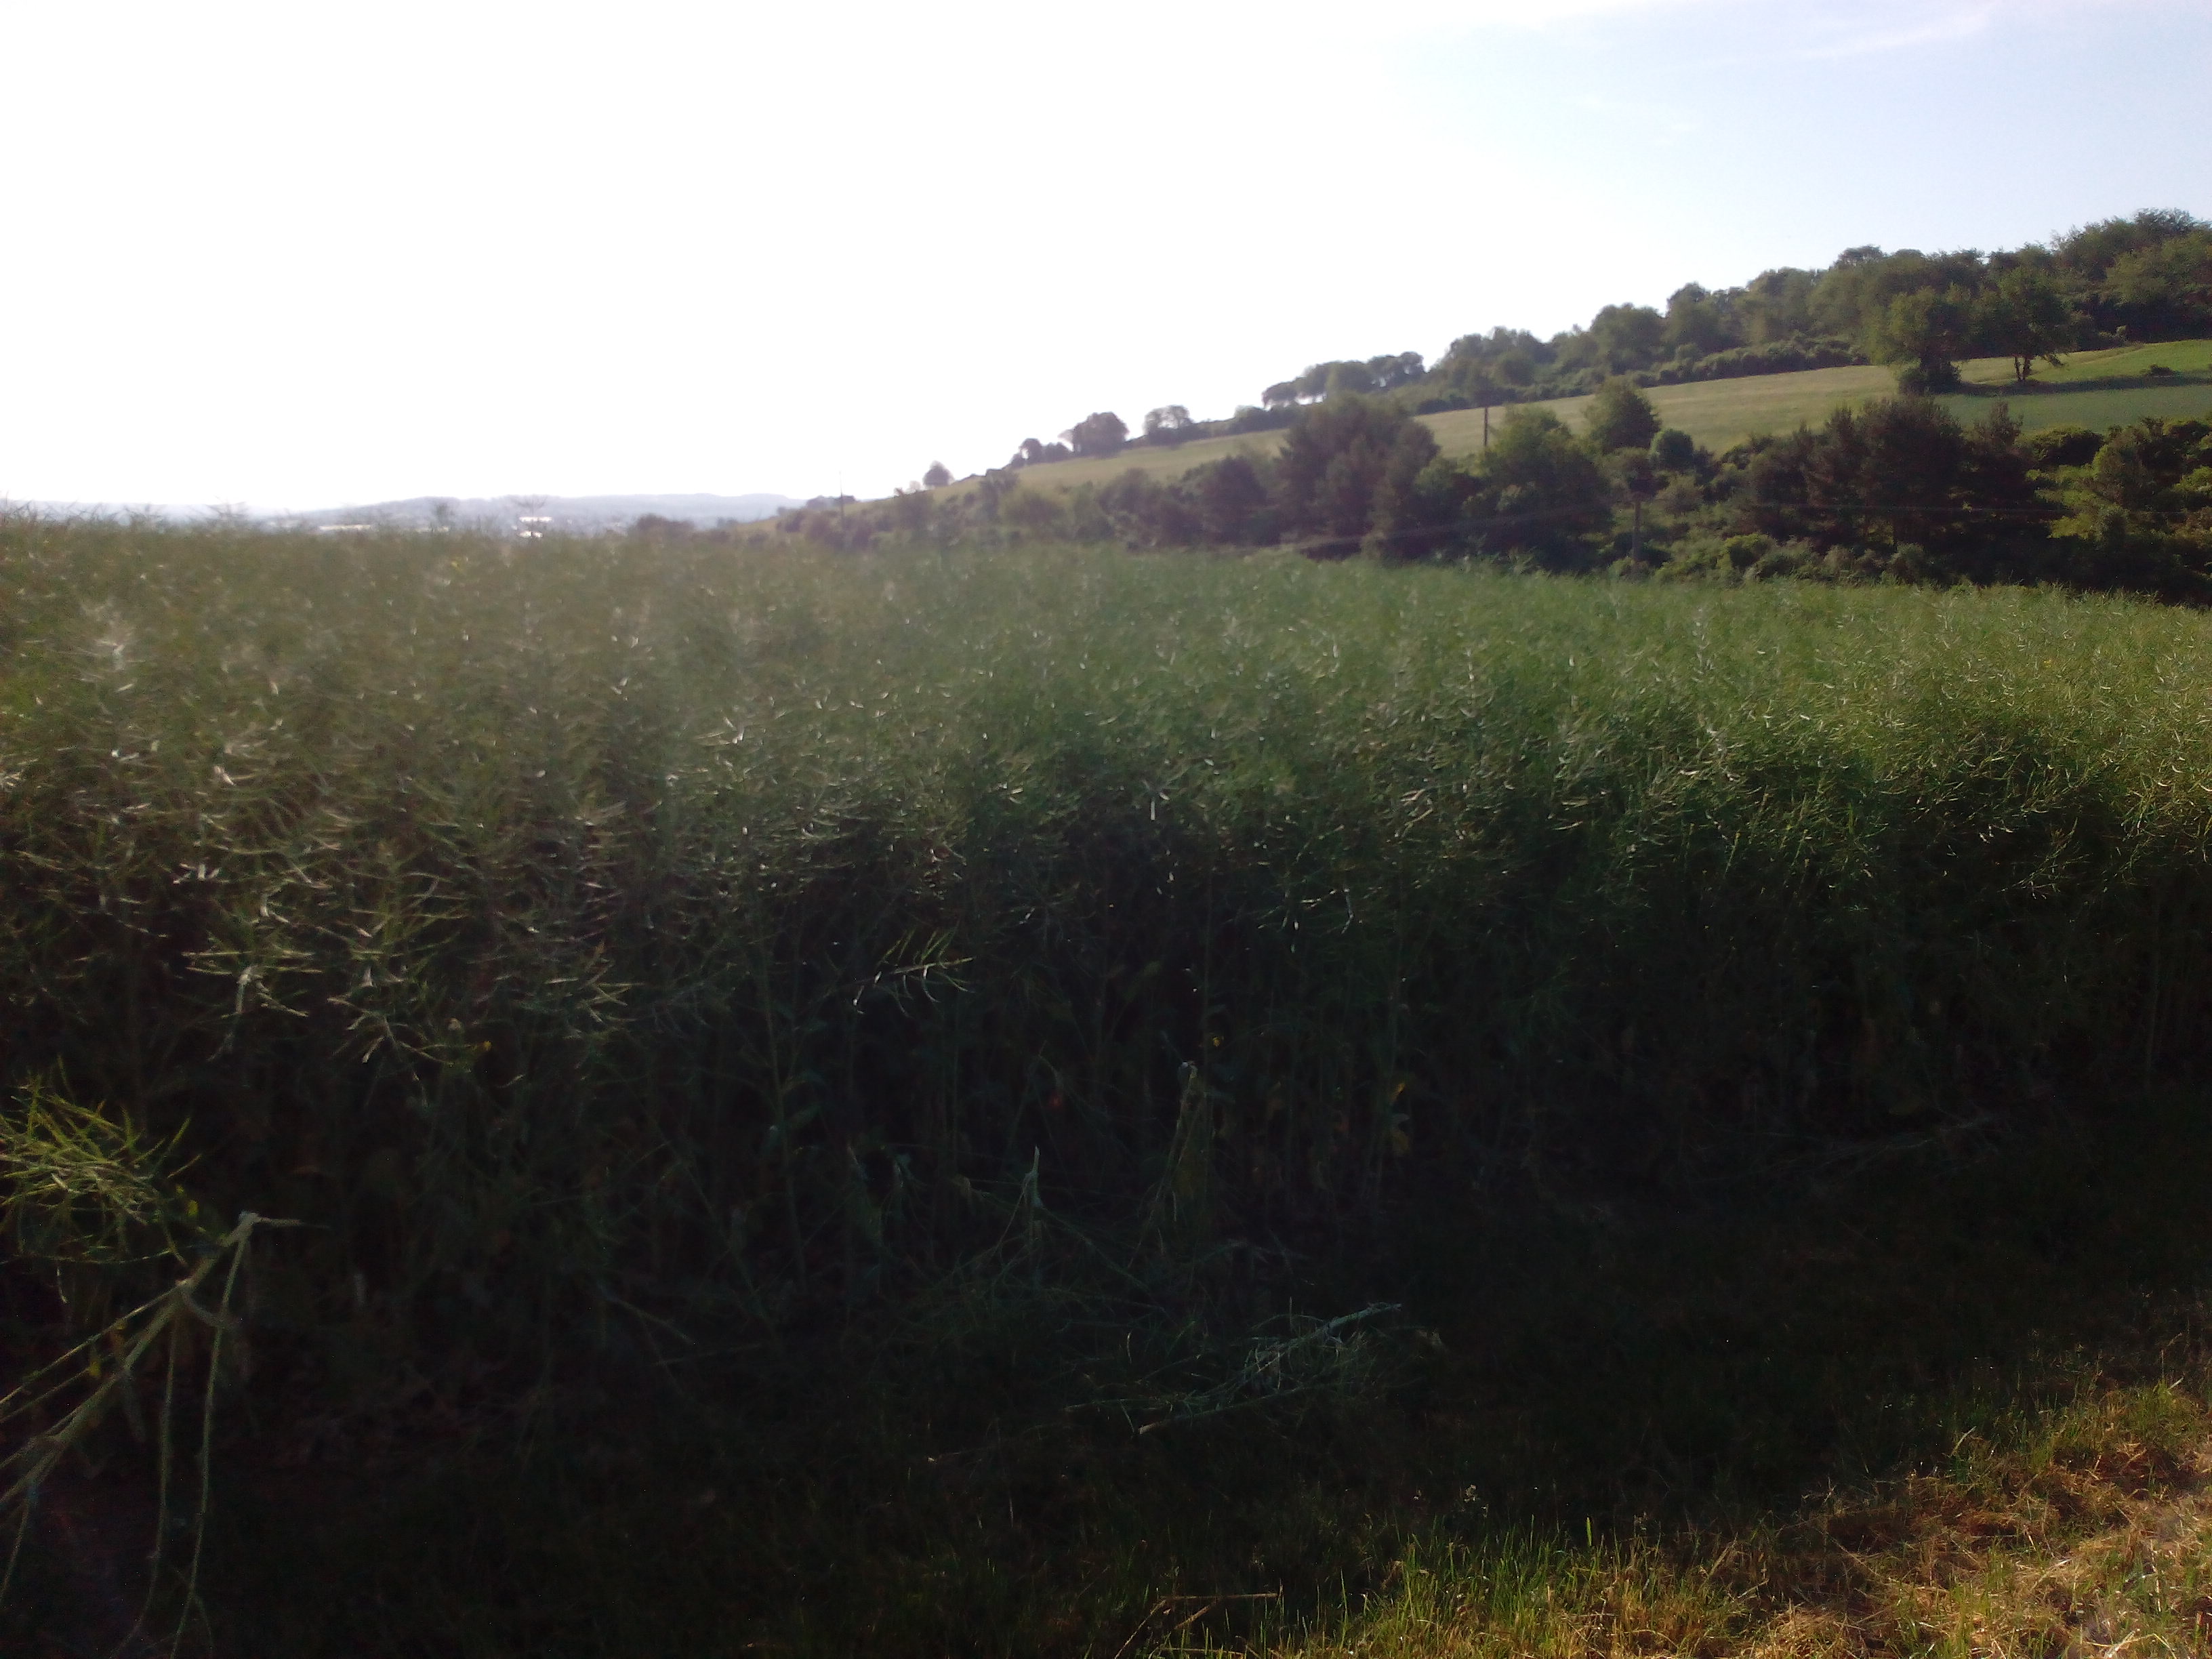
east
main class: Cropland
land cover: Rape and turnip rape
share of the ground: > 75 %
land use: Agriculture (excluding fallow land and kitchen gardens)
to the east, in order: Rape and turnip rape; Grass margins; Tracks; Rape and turnip rape; Grass margins; Ditches and canals; Grass margins; Tracks; Grass margins; Electric lines; Grass margins; Rye
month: June
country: DE
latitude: 50.4357
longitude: 10.2674
